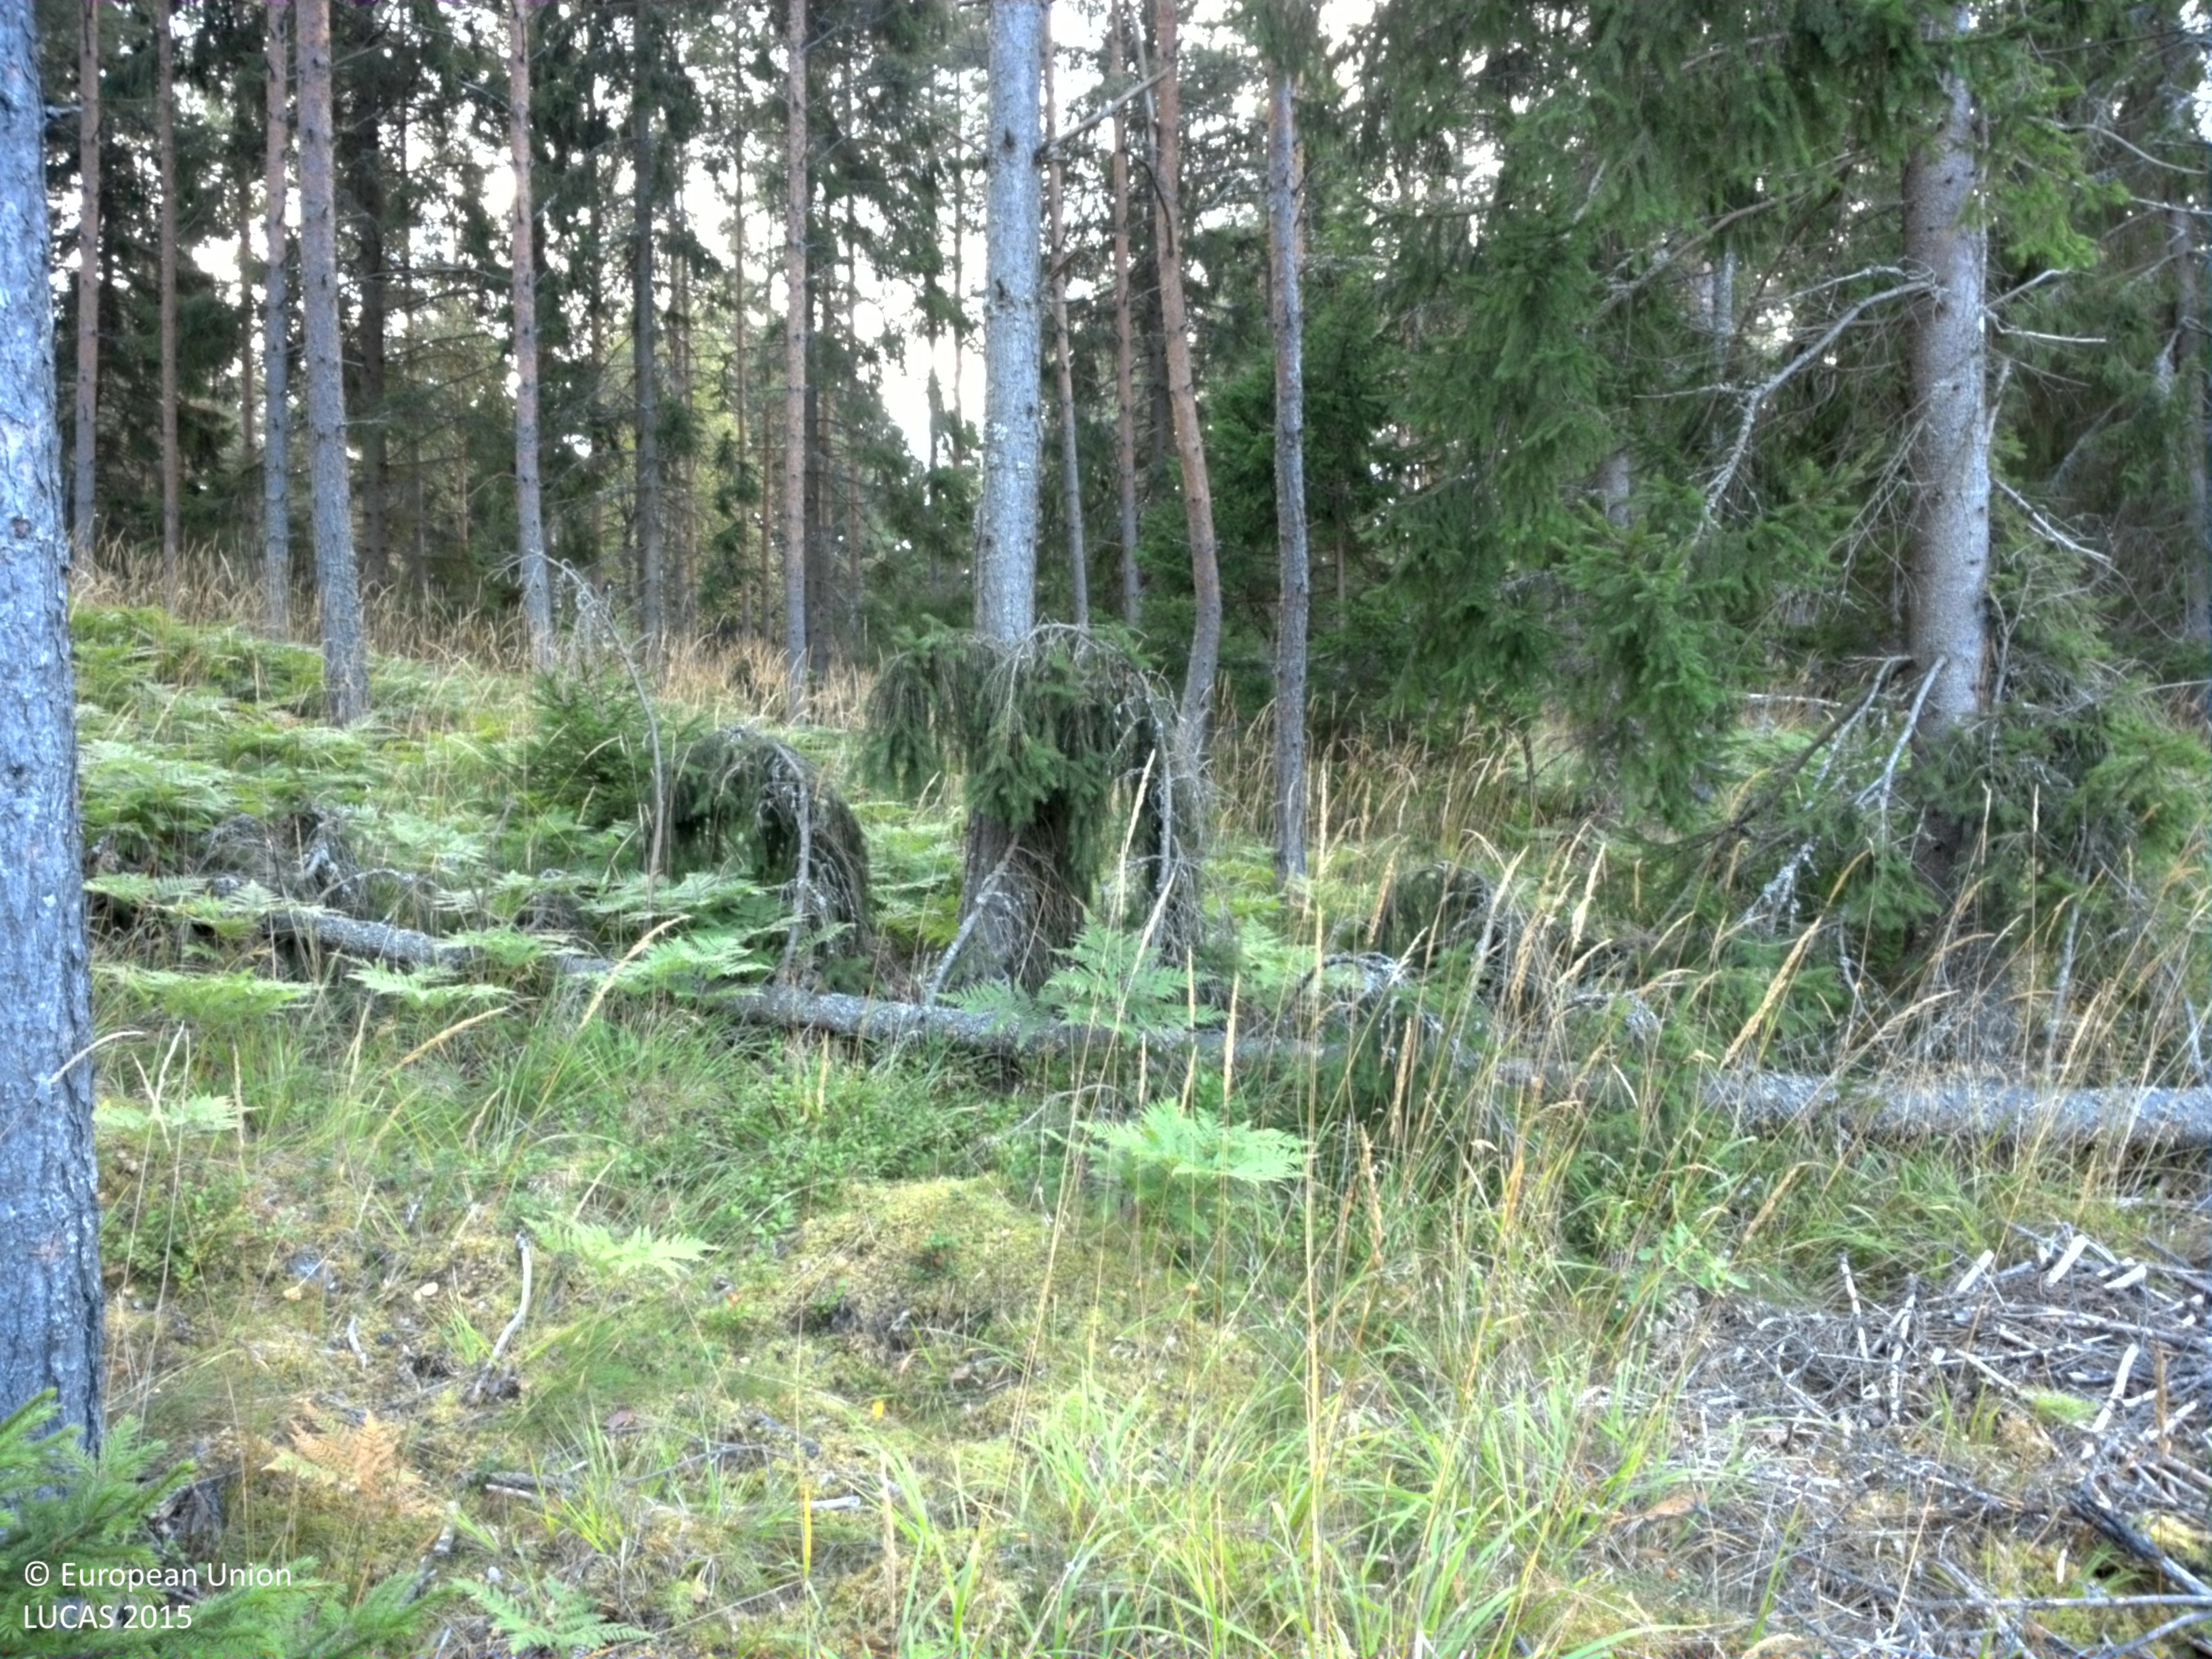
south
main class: Woodland
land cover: Pine dominated coniferous woodland
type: boreal forest
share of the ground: 50 - 75 %
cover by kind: coniferous forest trees 65 %, herbaceous plants 15 %, lichens and mosses 15 %, broadleaved forest trees 5 %
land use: Forestry
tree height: > 5 m
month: August
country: SE
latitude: 59.5781
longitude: 17.5910
